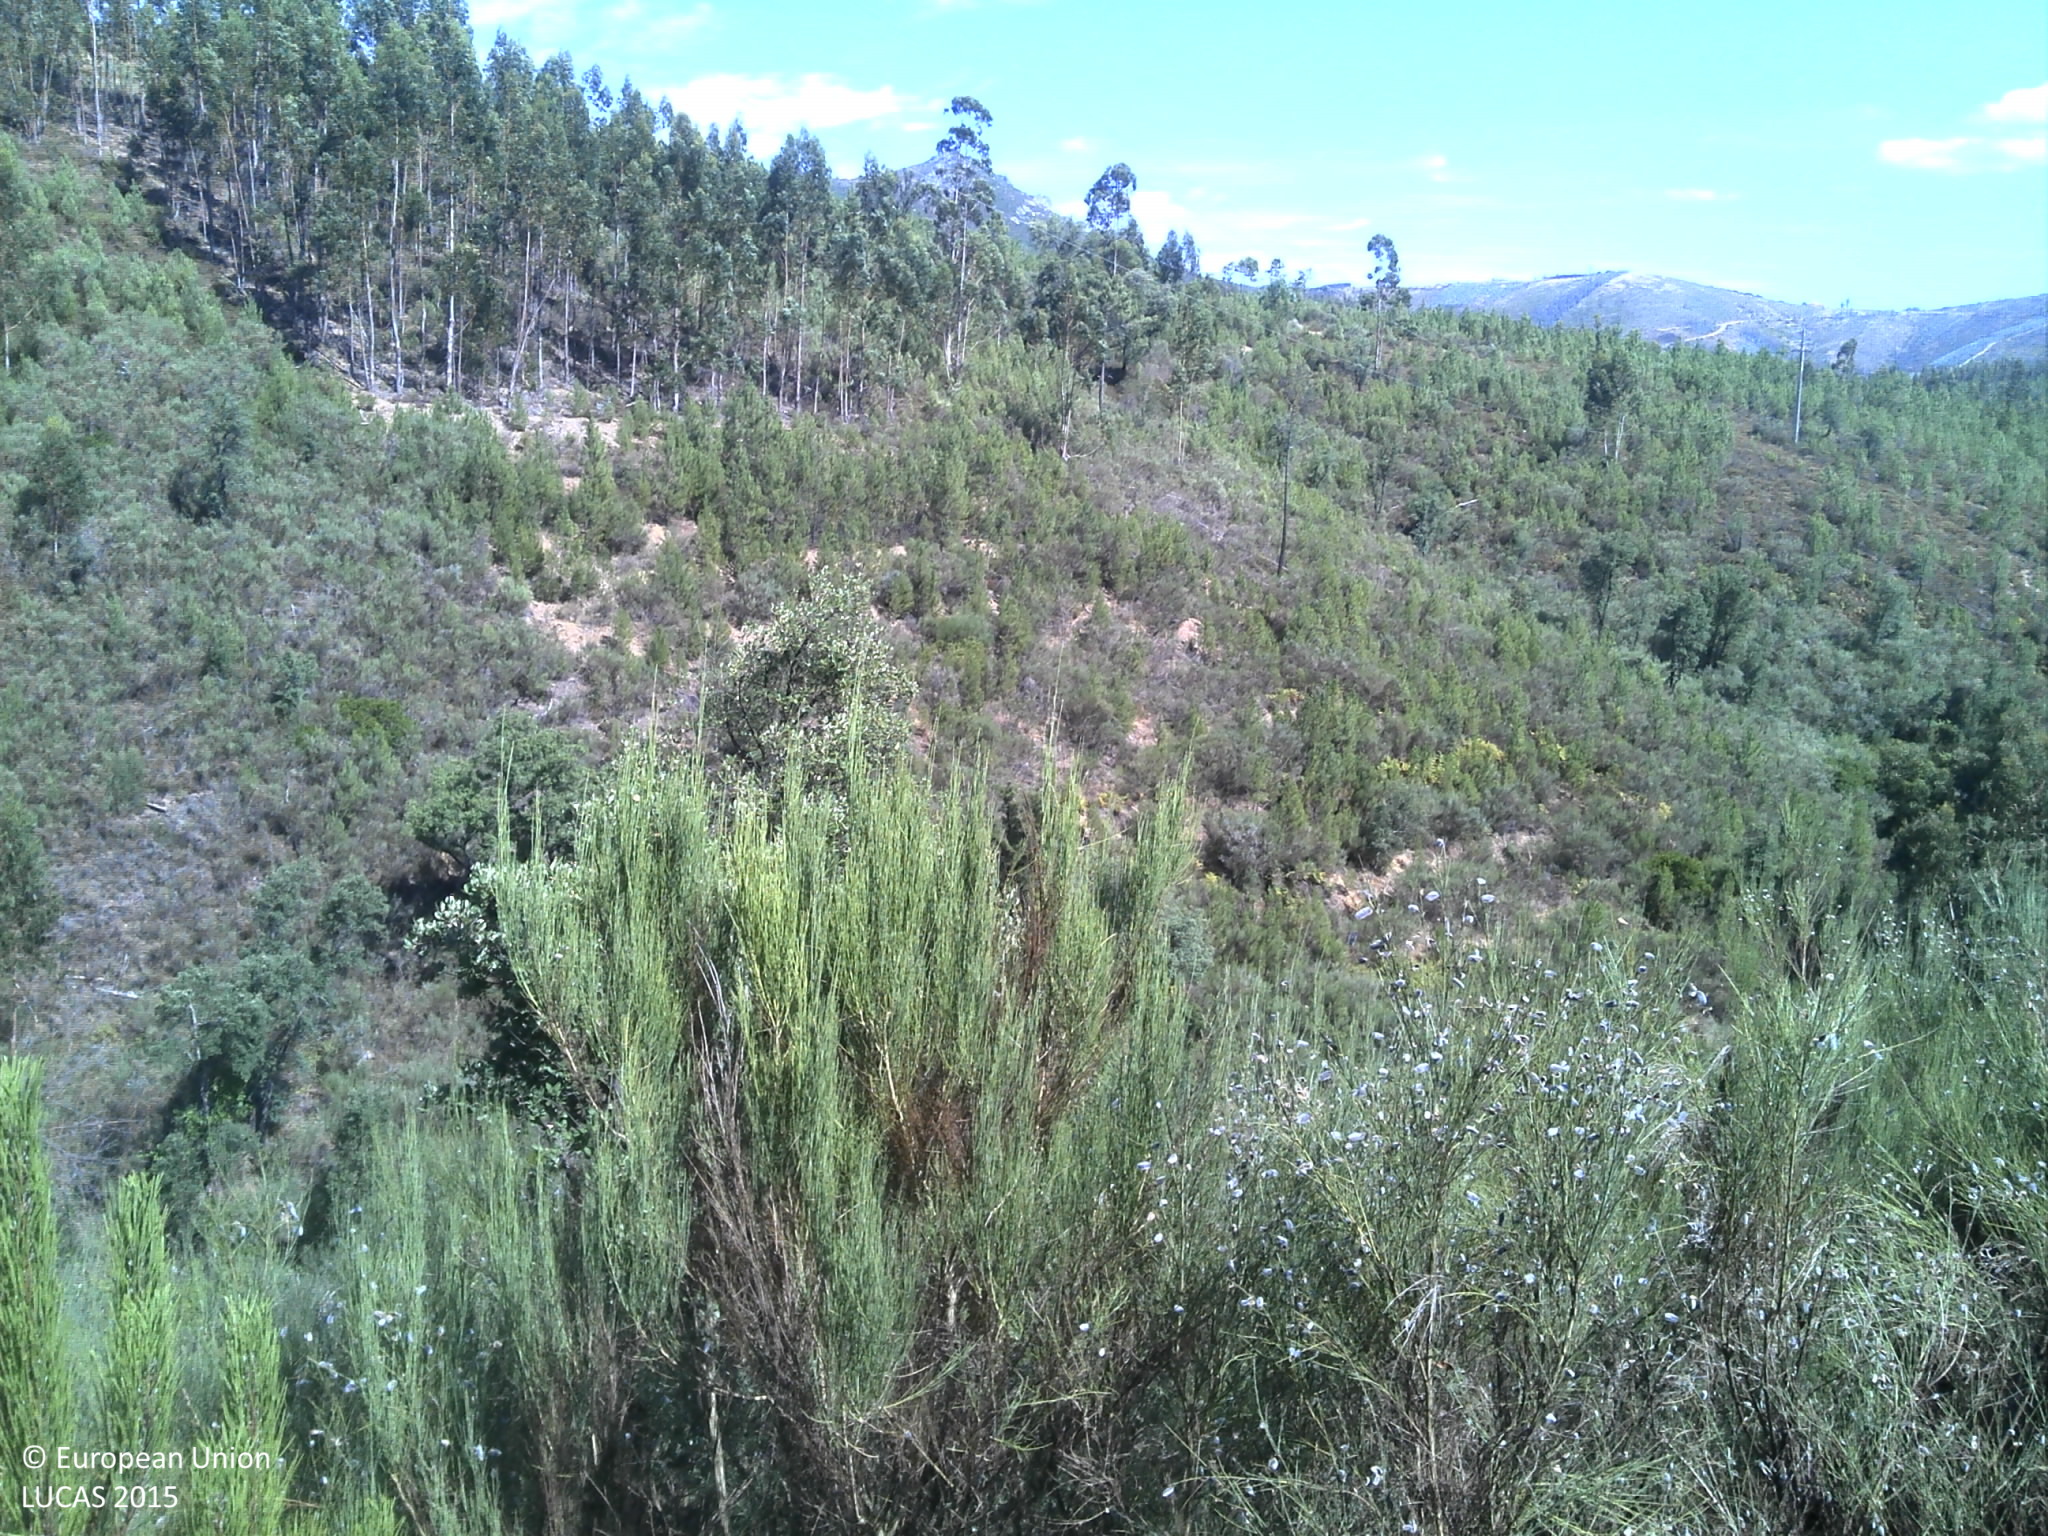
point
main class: Shrubland
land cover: Shrubland with sparse tree cover
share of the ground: > 75 %
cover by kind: shrubs 85 %, unconsolidated bare surface 10 %, coniferous forest trees 5 %
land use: Semi-natural and natural areas not in use
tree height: > 5 m
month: July
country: PT
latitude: 40.0873
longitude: -7.8818
